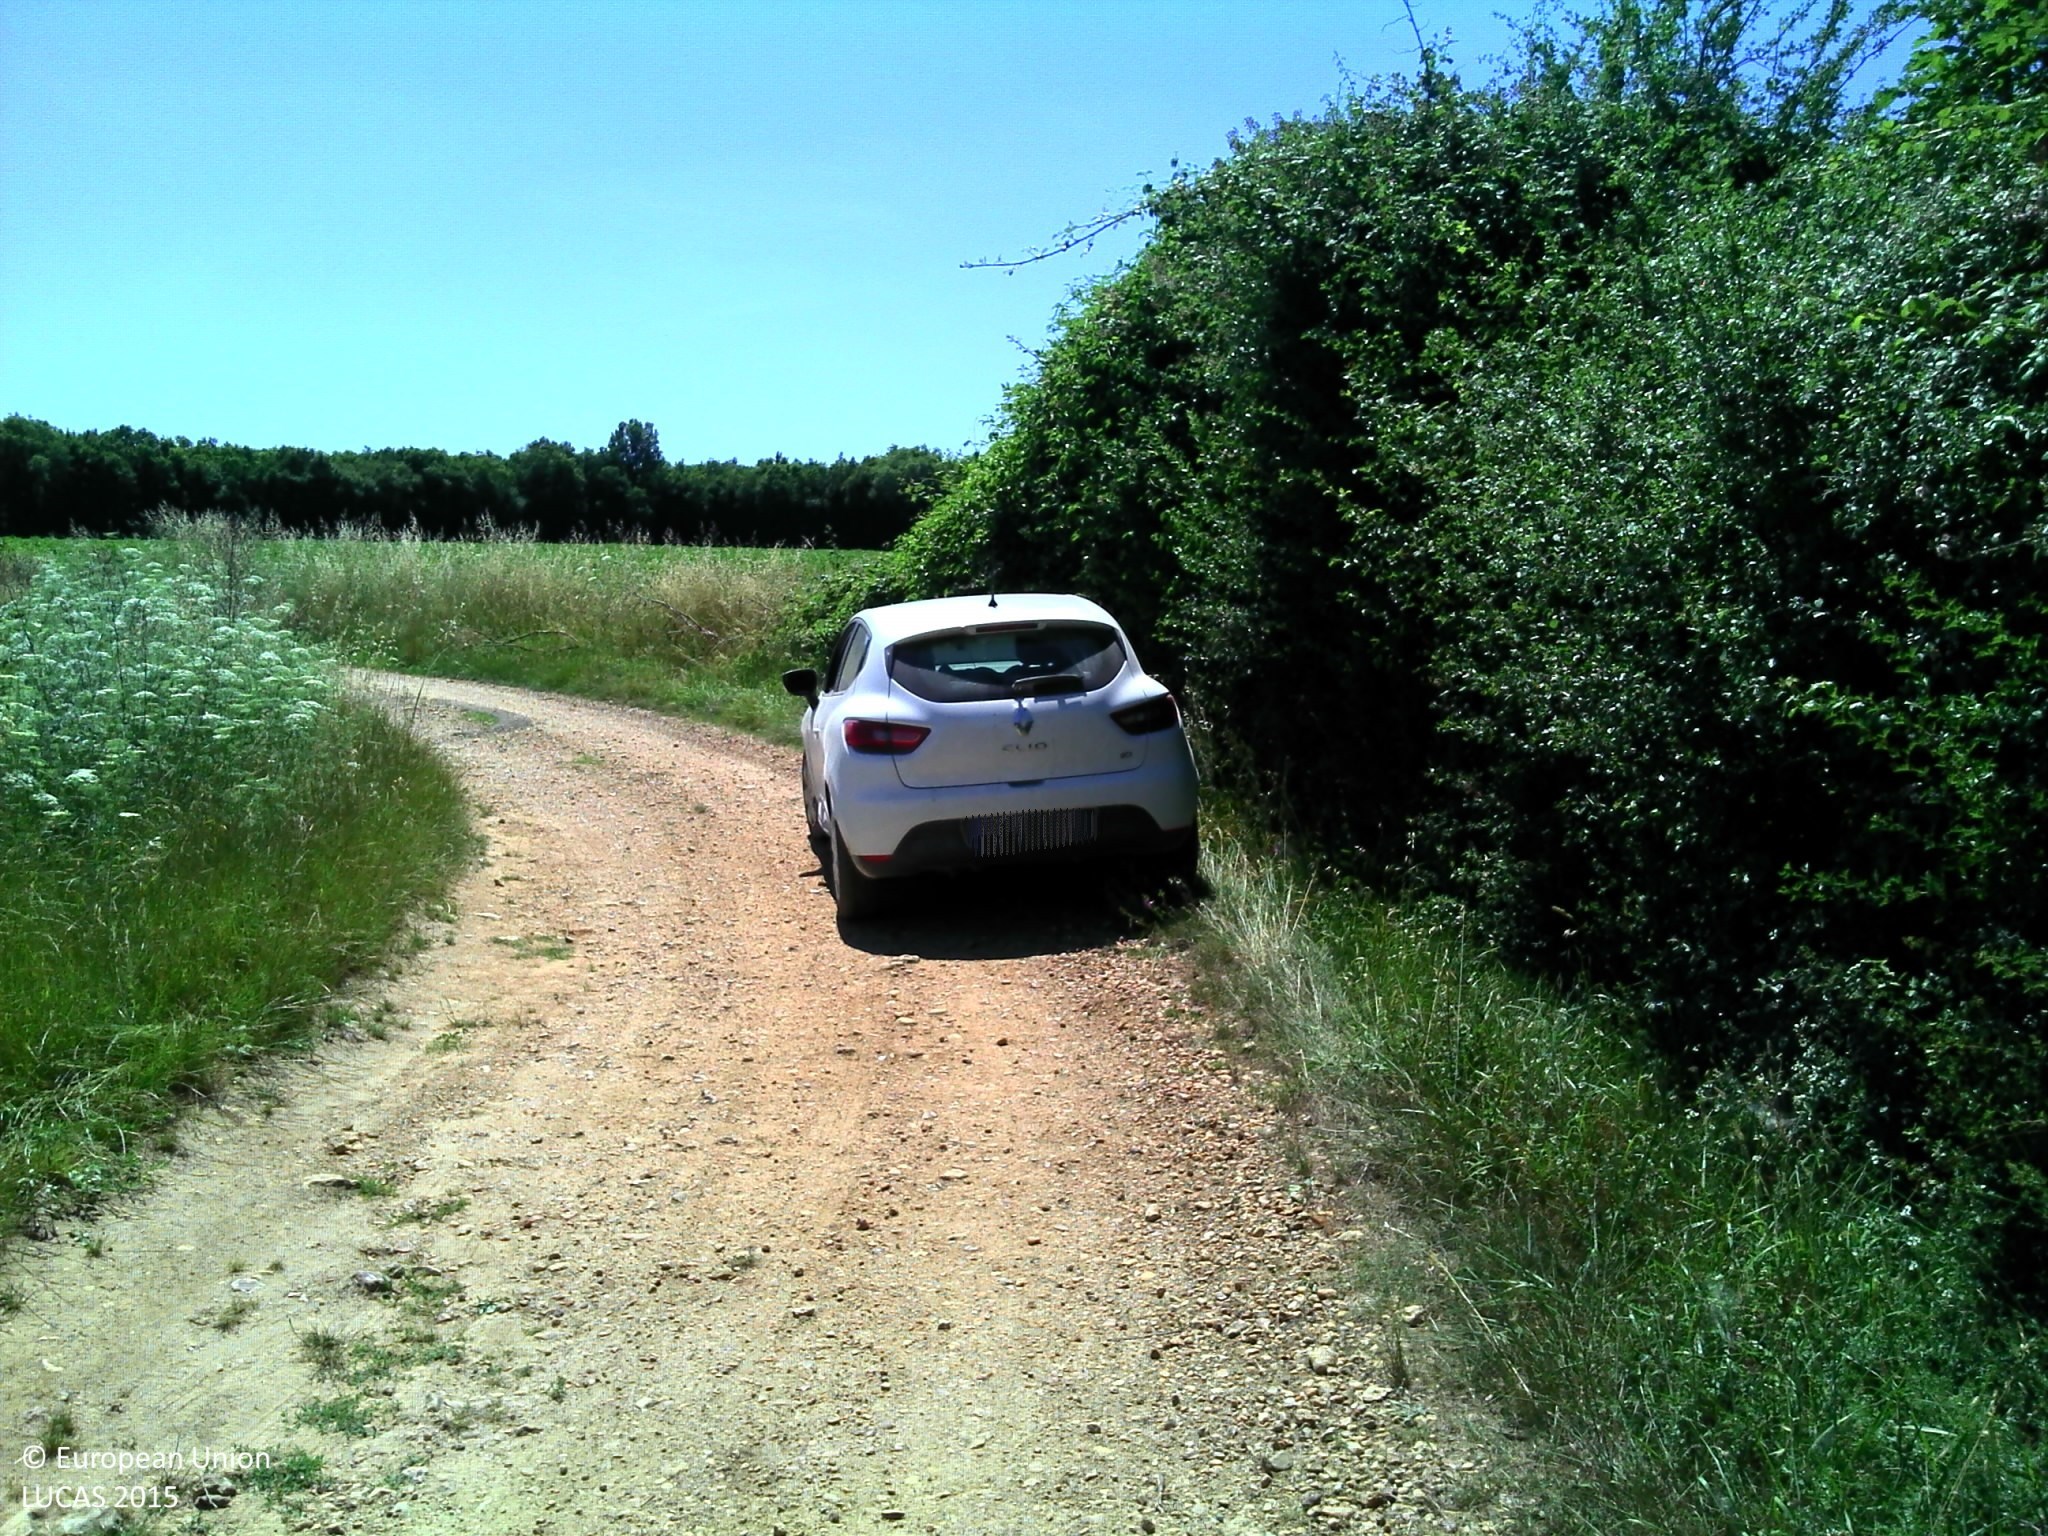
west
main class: Grassland
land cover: Grassland with sparse tree/shrub cover
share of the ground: > 75 %
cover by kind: herbaceous plants 95 %, coniferous forest trees 5 %
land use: Residential
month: June
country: FR
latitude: 45.8161
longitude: -0.6682
